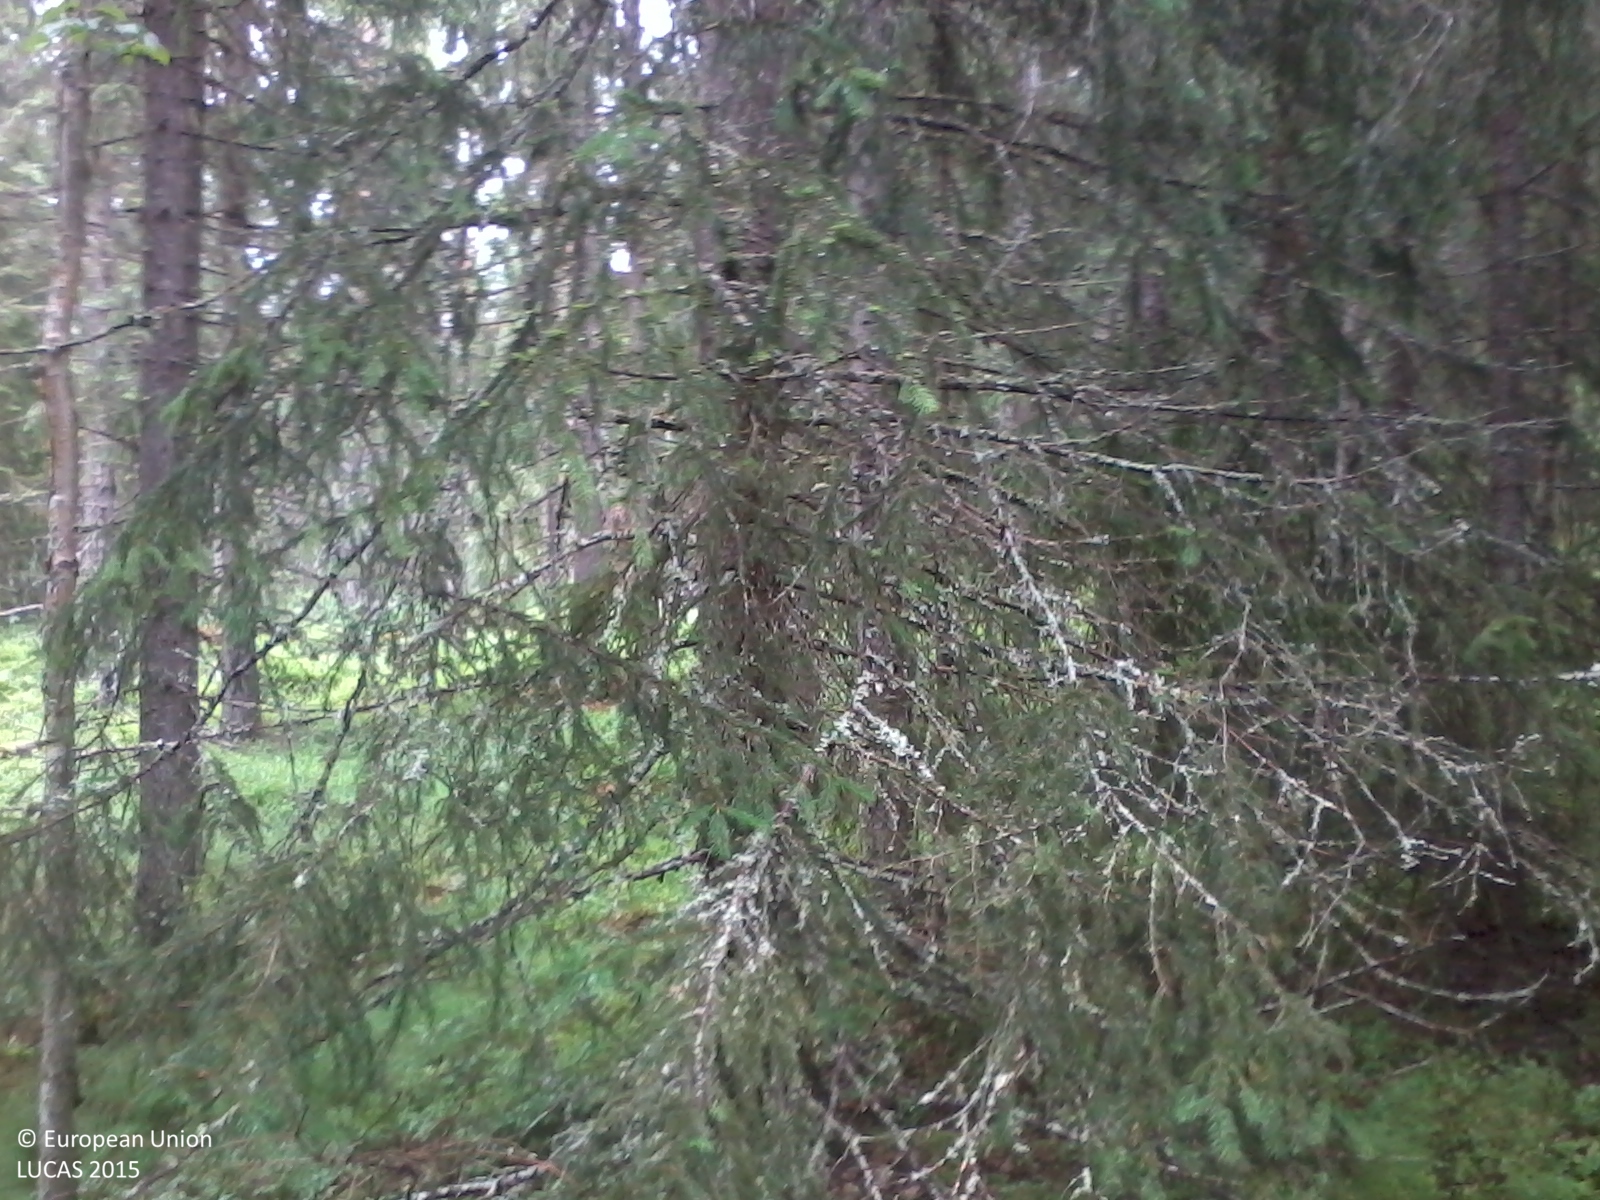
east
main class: Woodland
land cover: Spruce dominated mixed woodland
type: boreal forest
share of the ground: > 75 %
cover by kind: coniferous forest trees 60 %, broadleaved forest trees 20 %, shrubs 15 %, lichens and mosses 5 %
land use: Forestry
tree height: > 5 m
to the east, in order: Spruce dominated mixed woodland; Ditches and canals; Spruce dominated mixed woodland; Pine dominated coniferous woodland; Ditches and canals; Spruce dominated coniferous woodland
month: July
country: SE
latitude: 63.6316
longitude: 17.2985
